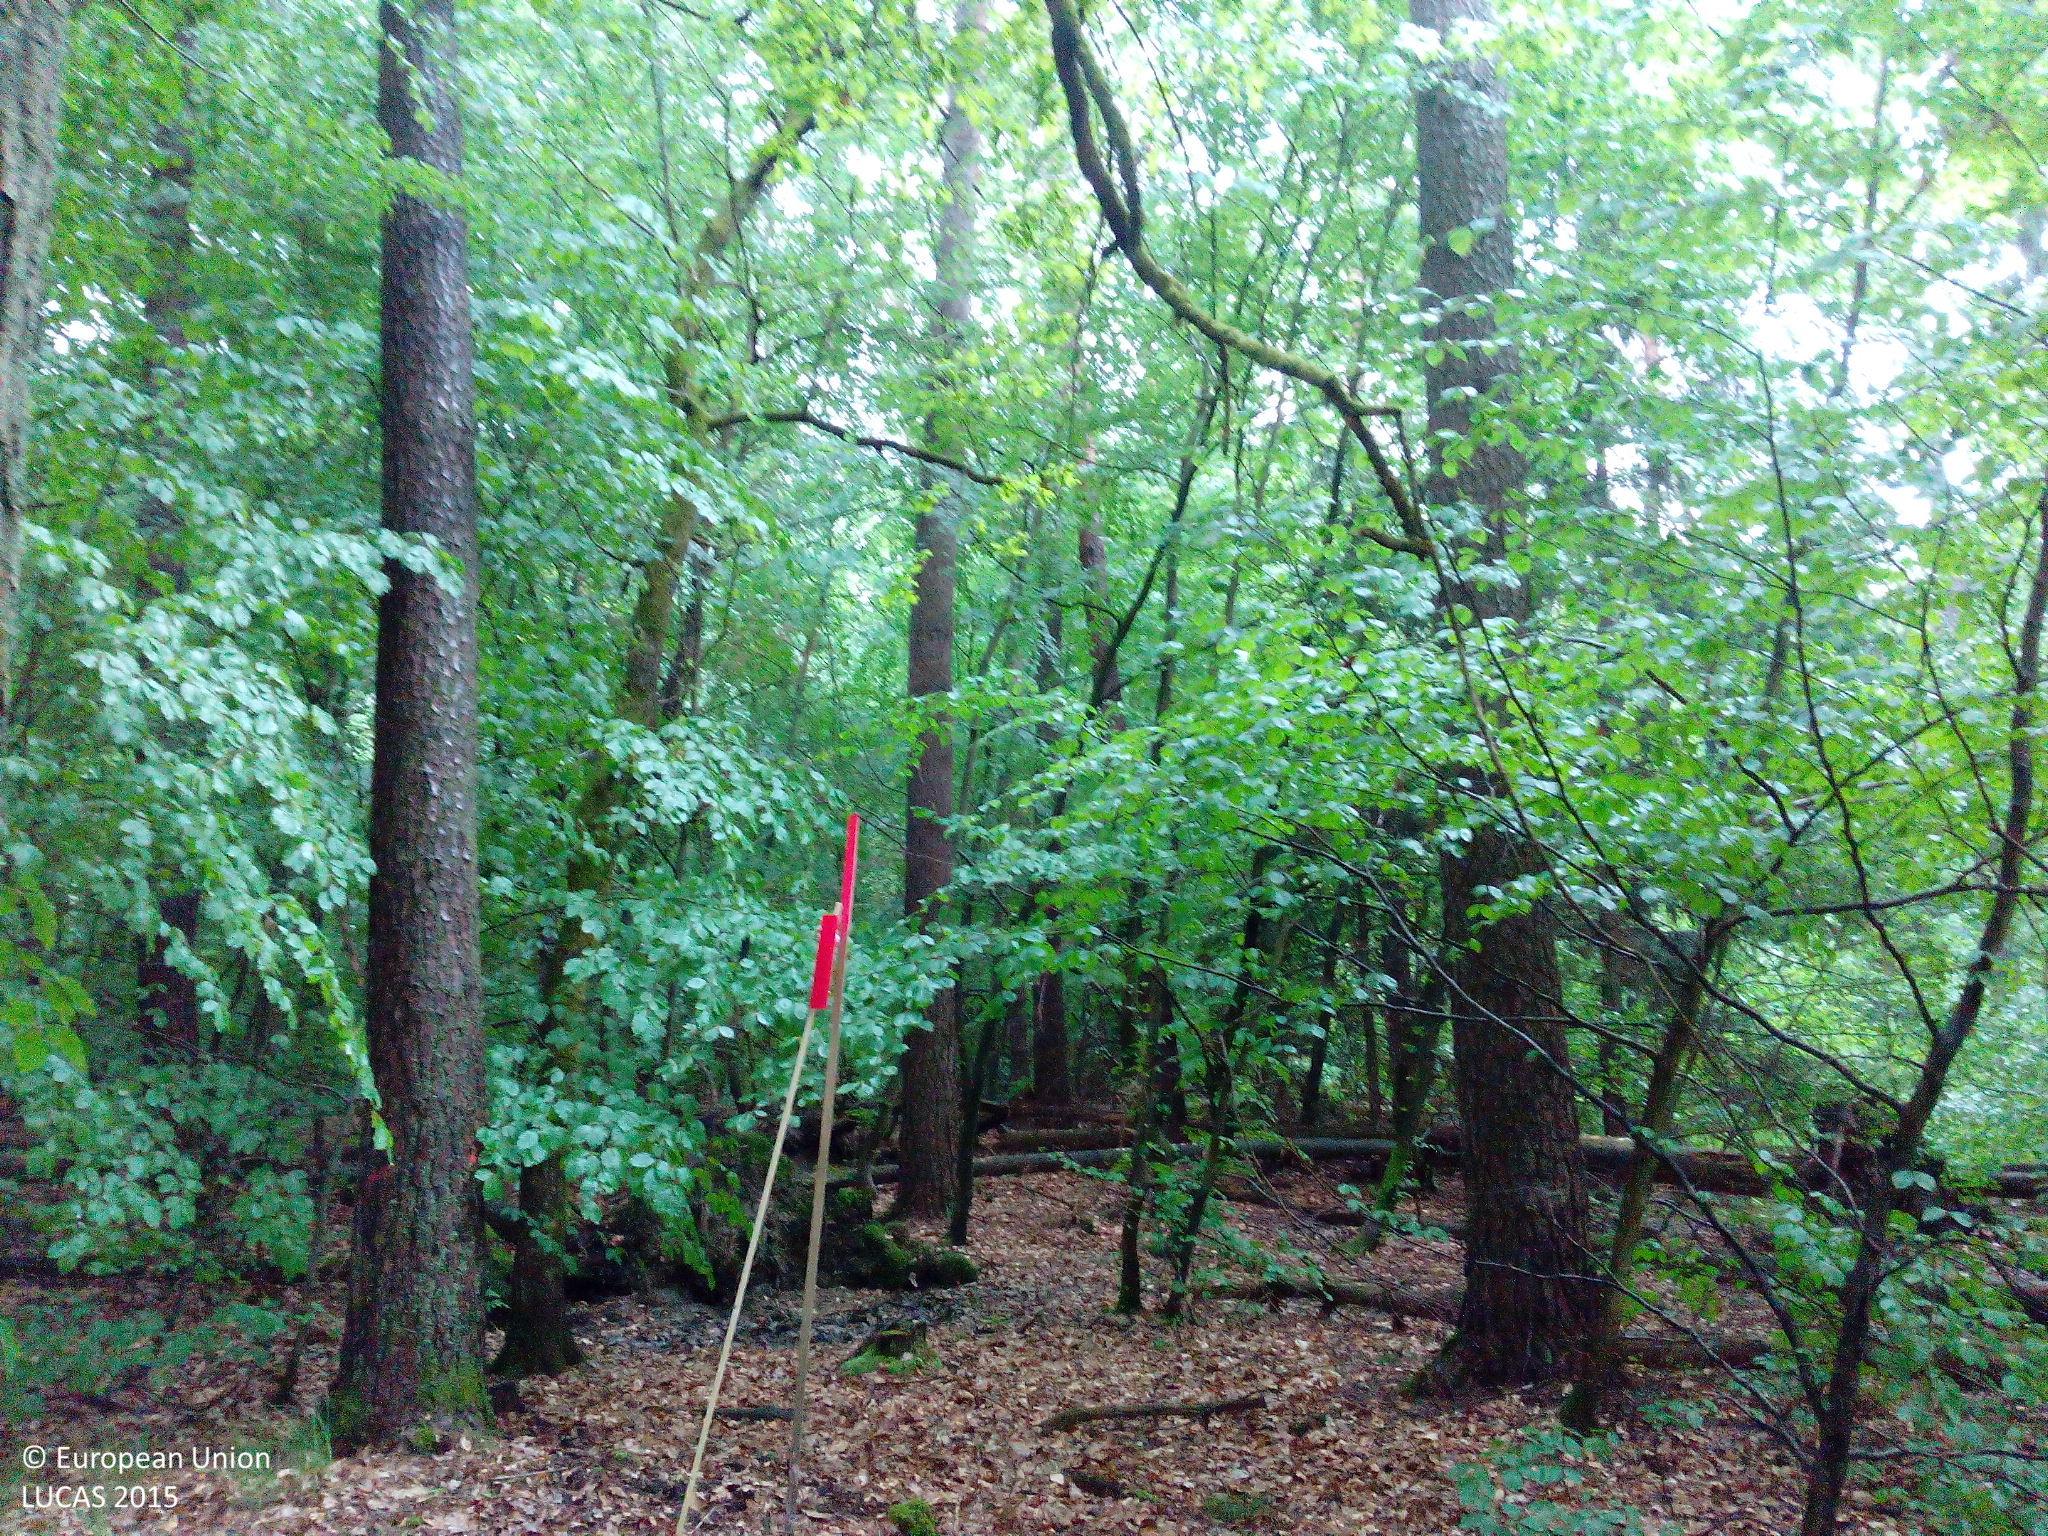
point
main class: Woodland
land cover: Broadleaved woodland
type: beech forest
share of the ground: > 75 %
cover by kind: broadleaved forest trees 70 %, coniferous forest trees 10 %, shrubs 10 %, unconsolidated bare surface 10 %
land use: Forestry
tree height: > 5 m
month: May
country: DE
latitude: 49.0359
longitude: 8.1540
